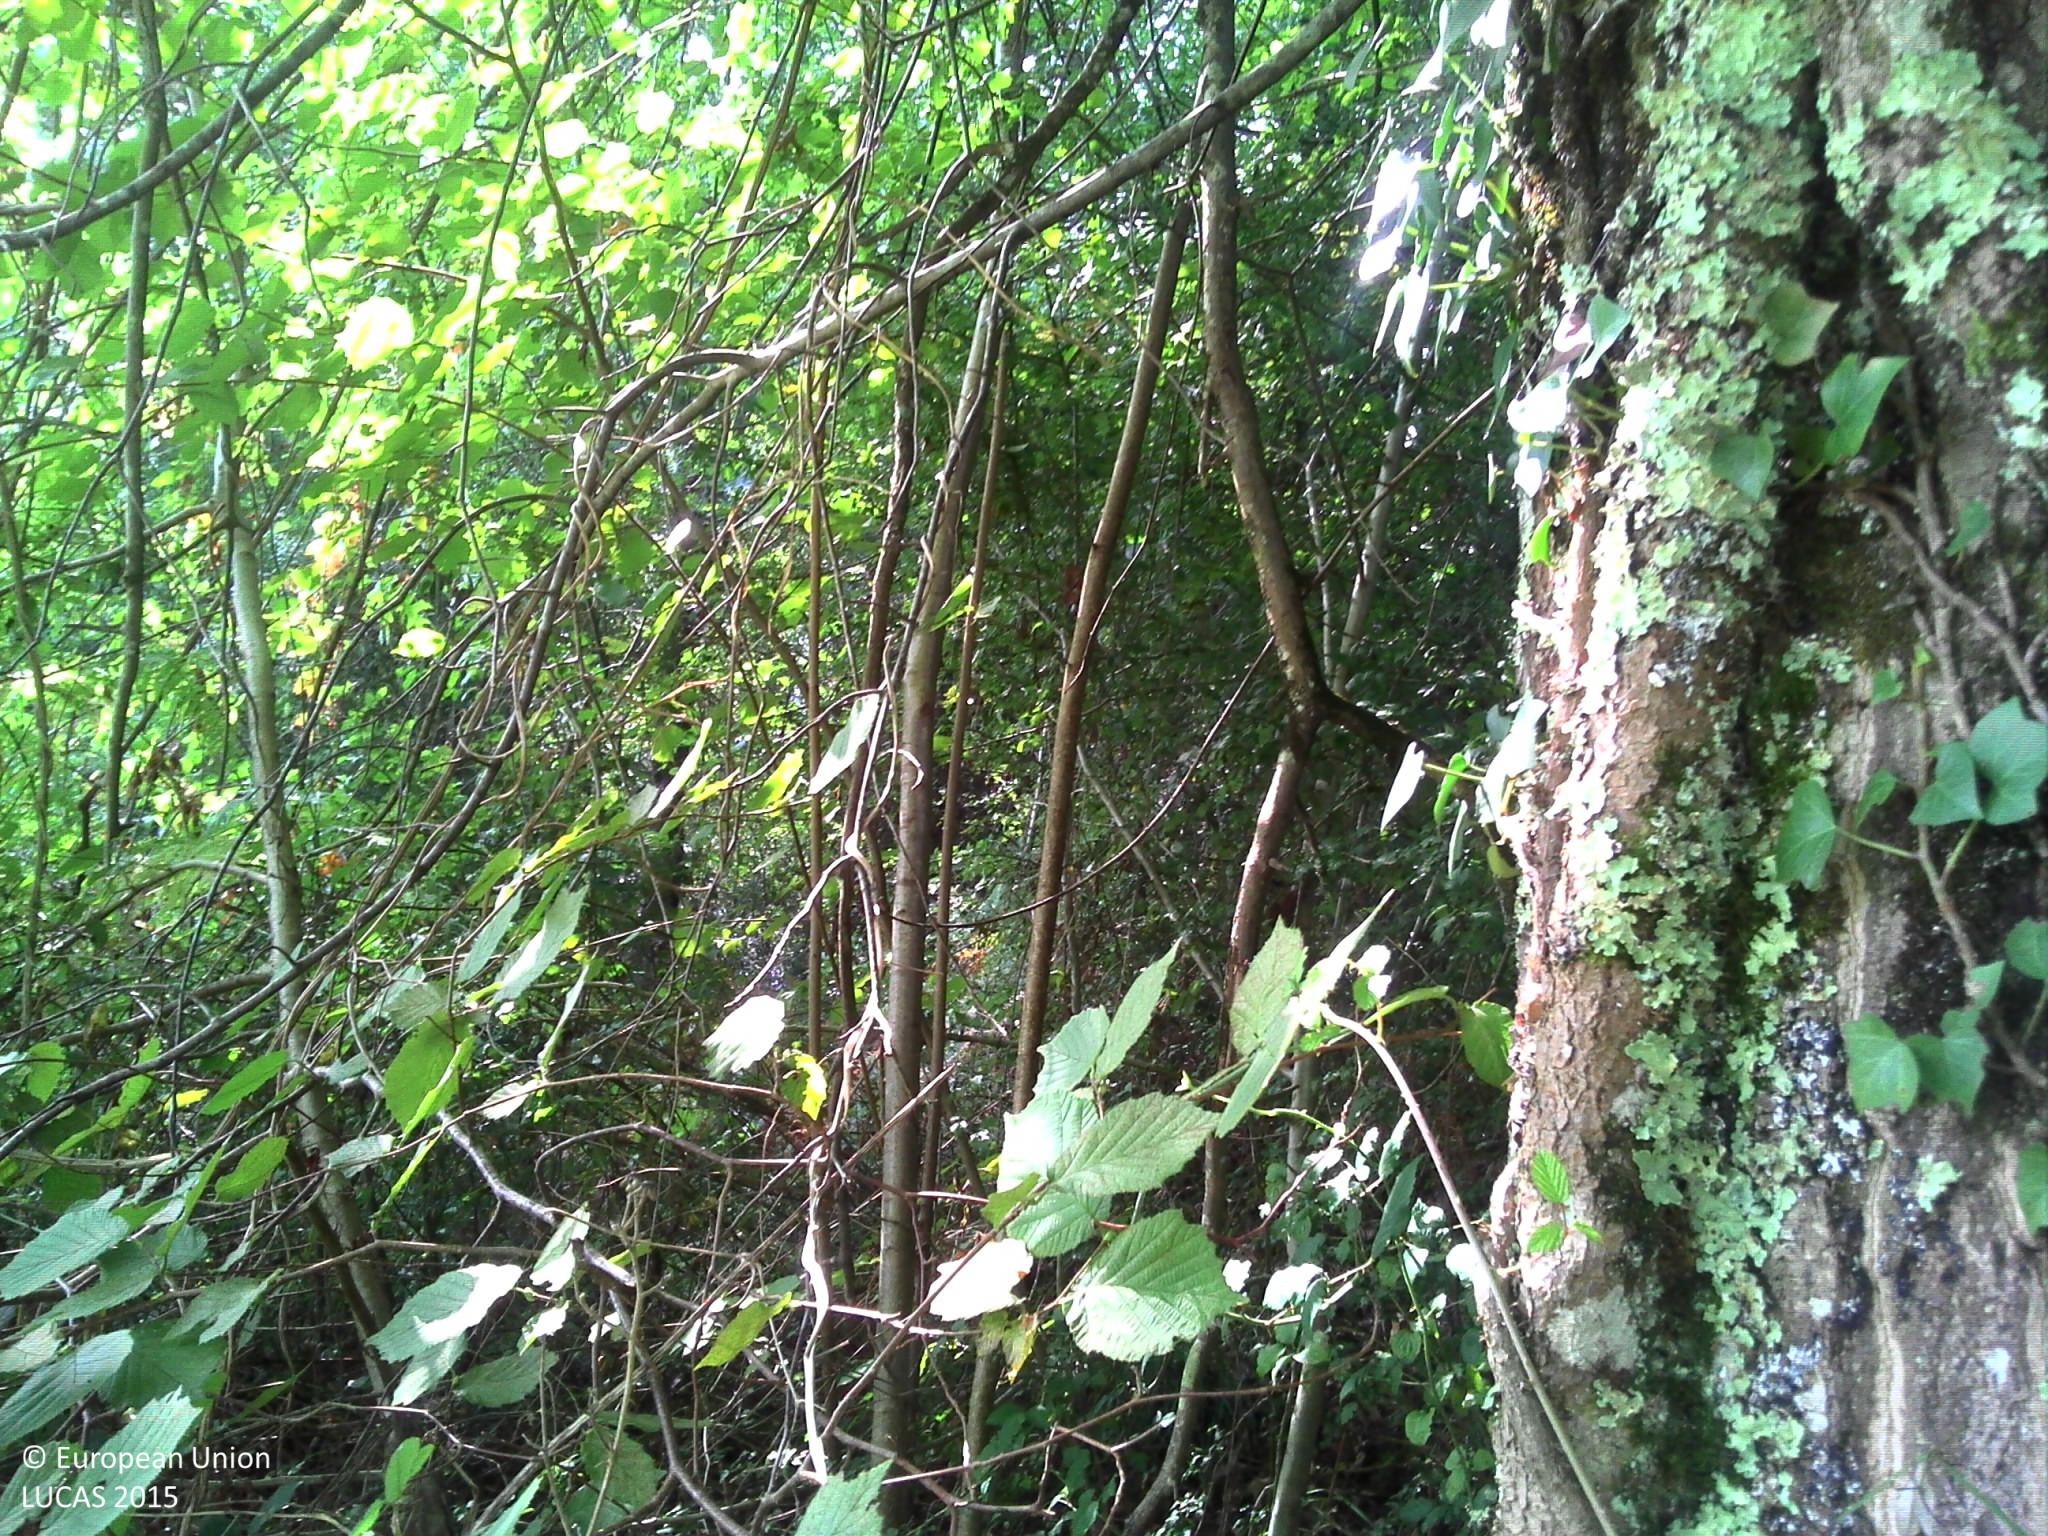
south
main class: Woodland
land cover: Broadleaved woodland
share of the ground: > 75 %
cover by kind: broadleaved forest trees 60 %, shrubs 30 %, herbaceous plants 5 %, lichens and mosses 5 %
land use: Forestry
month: September
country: FR
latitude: 43.1972
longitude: -1.0256
